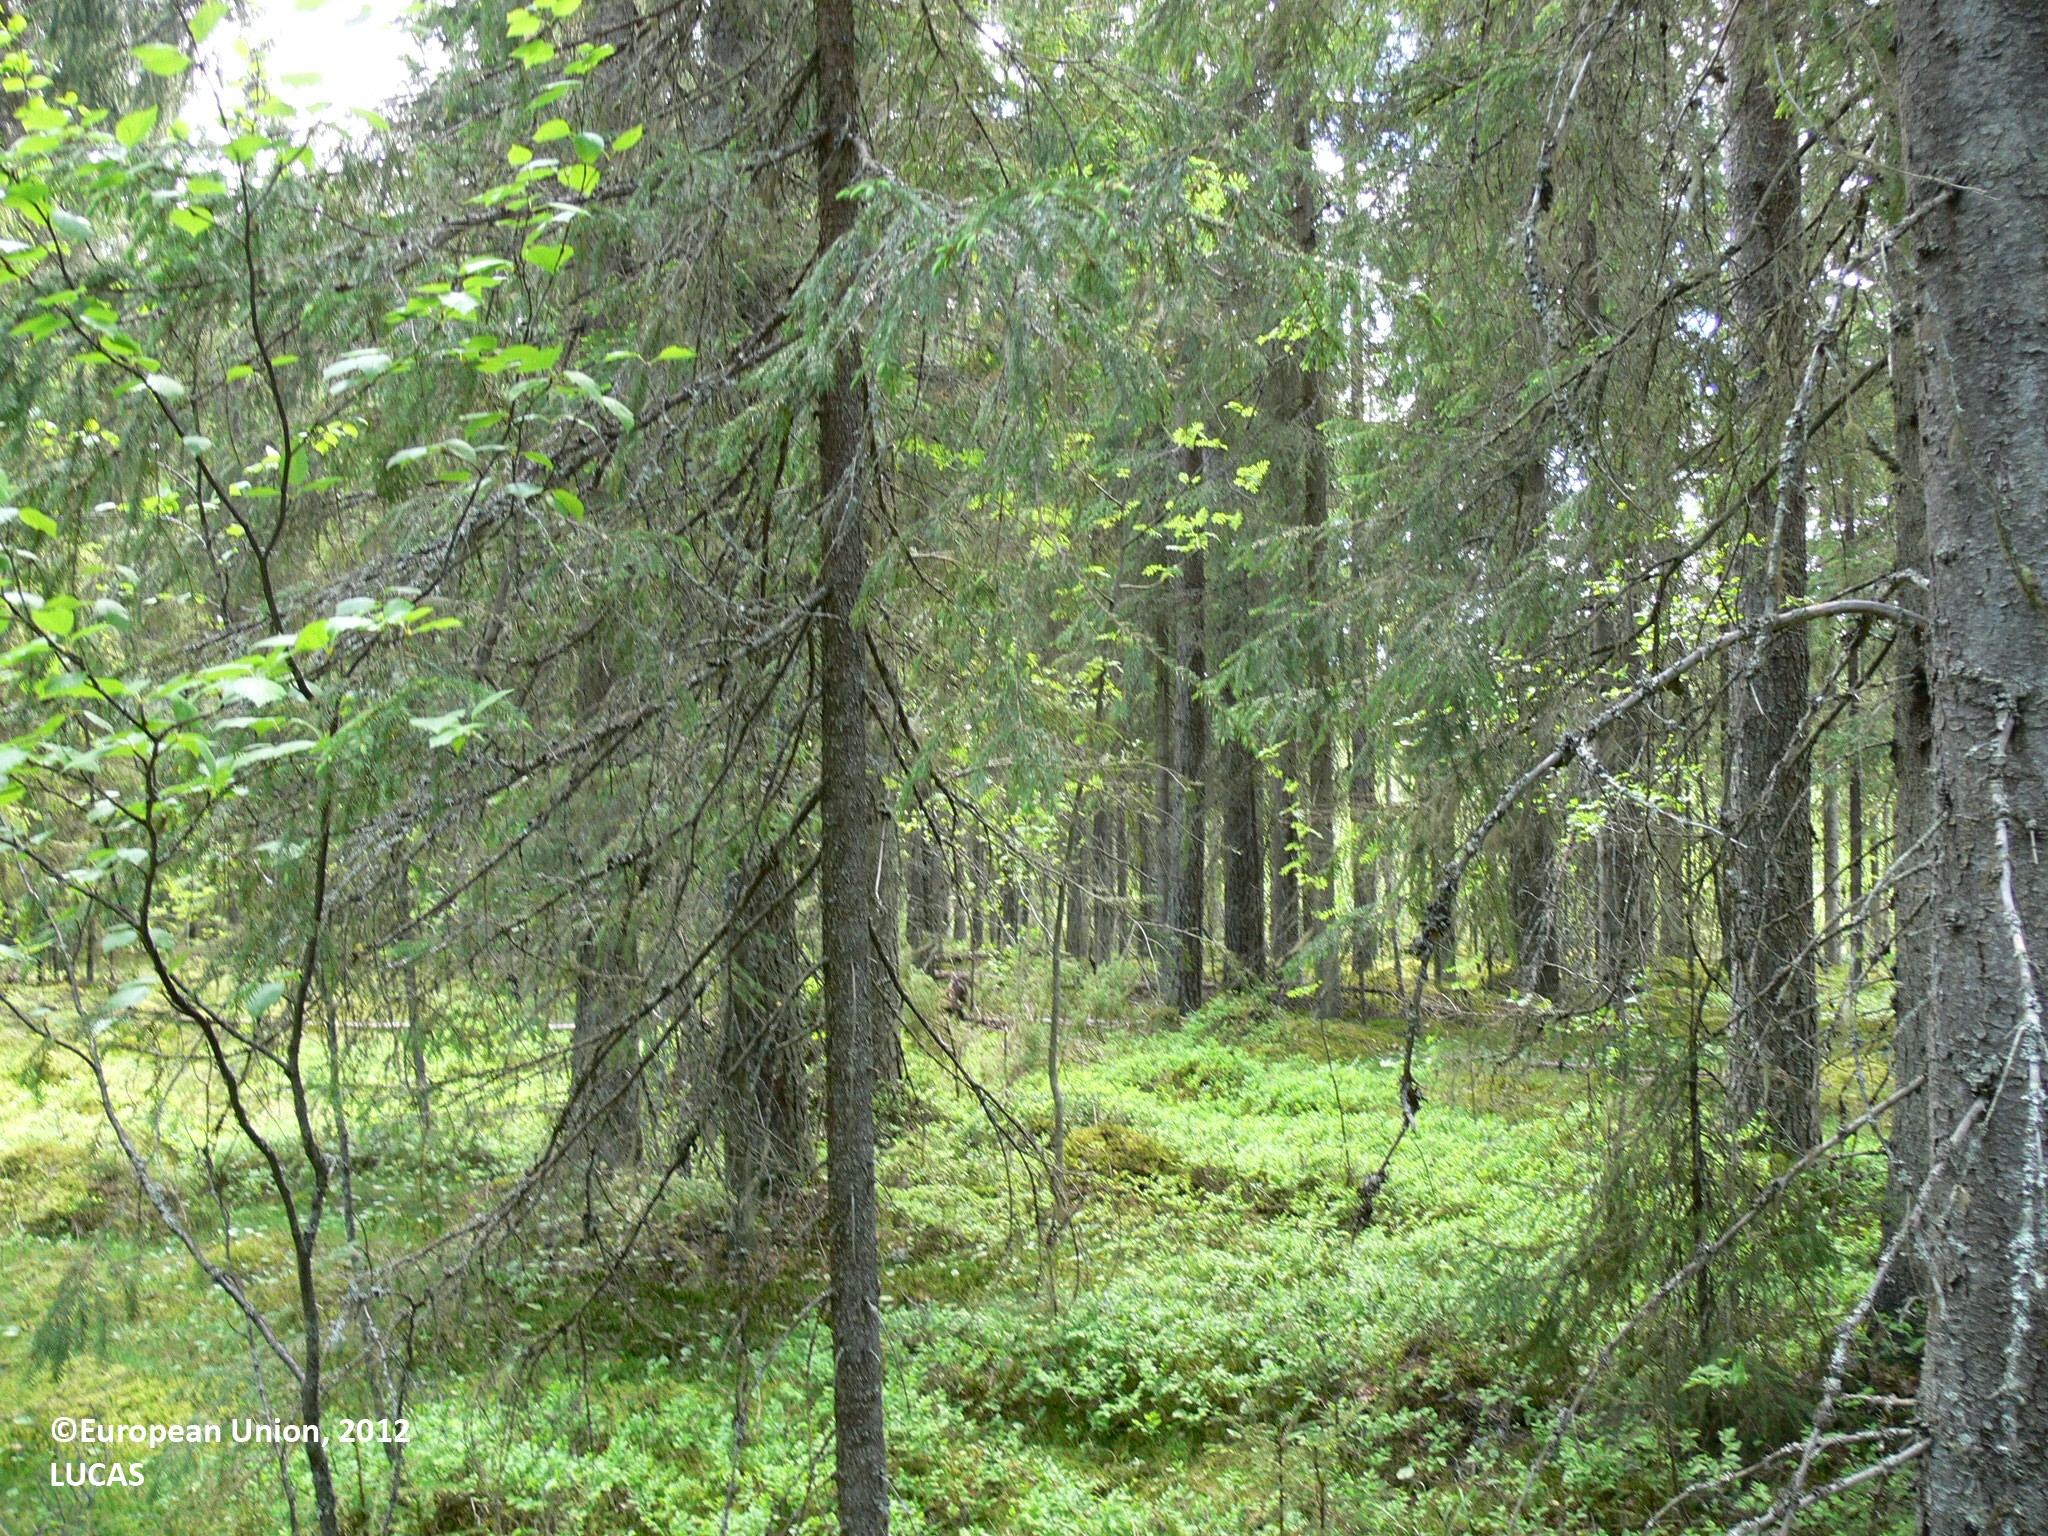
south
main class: Woodland
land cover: Spruce dominated coniferous woodland
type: boreal forest
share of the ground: > 75 %
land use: Forestry
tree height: > 5 m
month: June
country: FI
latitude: 62.5658
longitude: 30.6180
